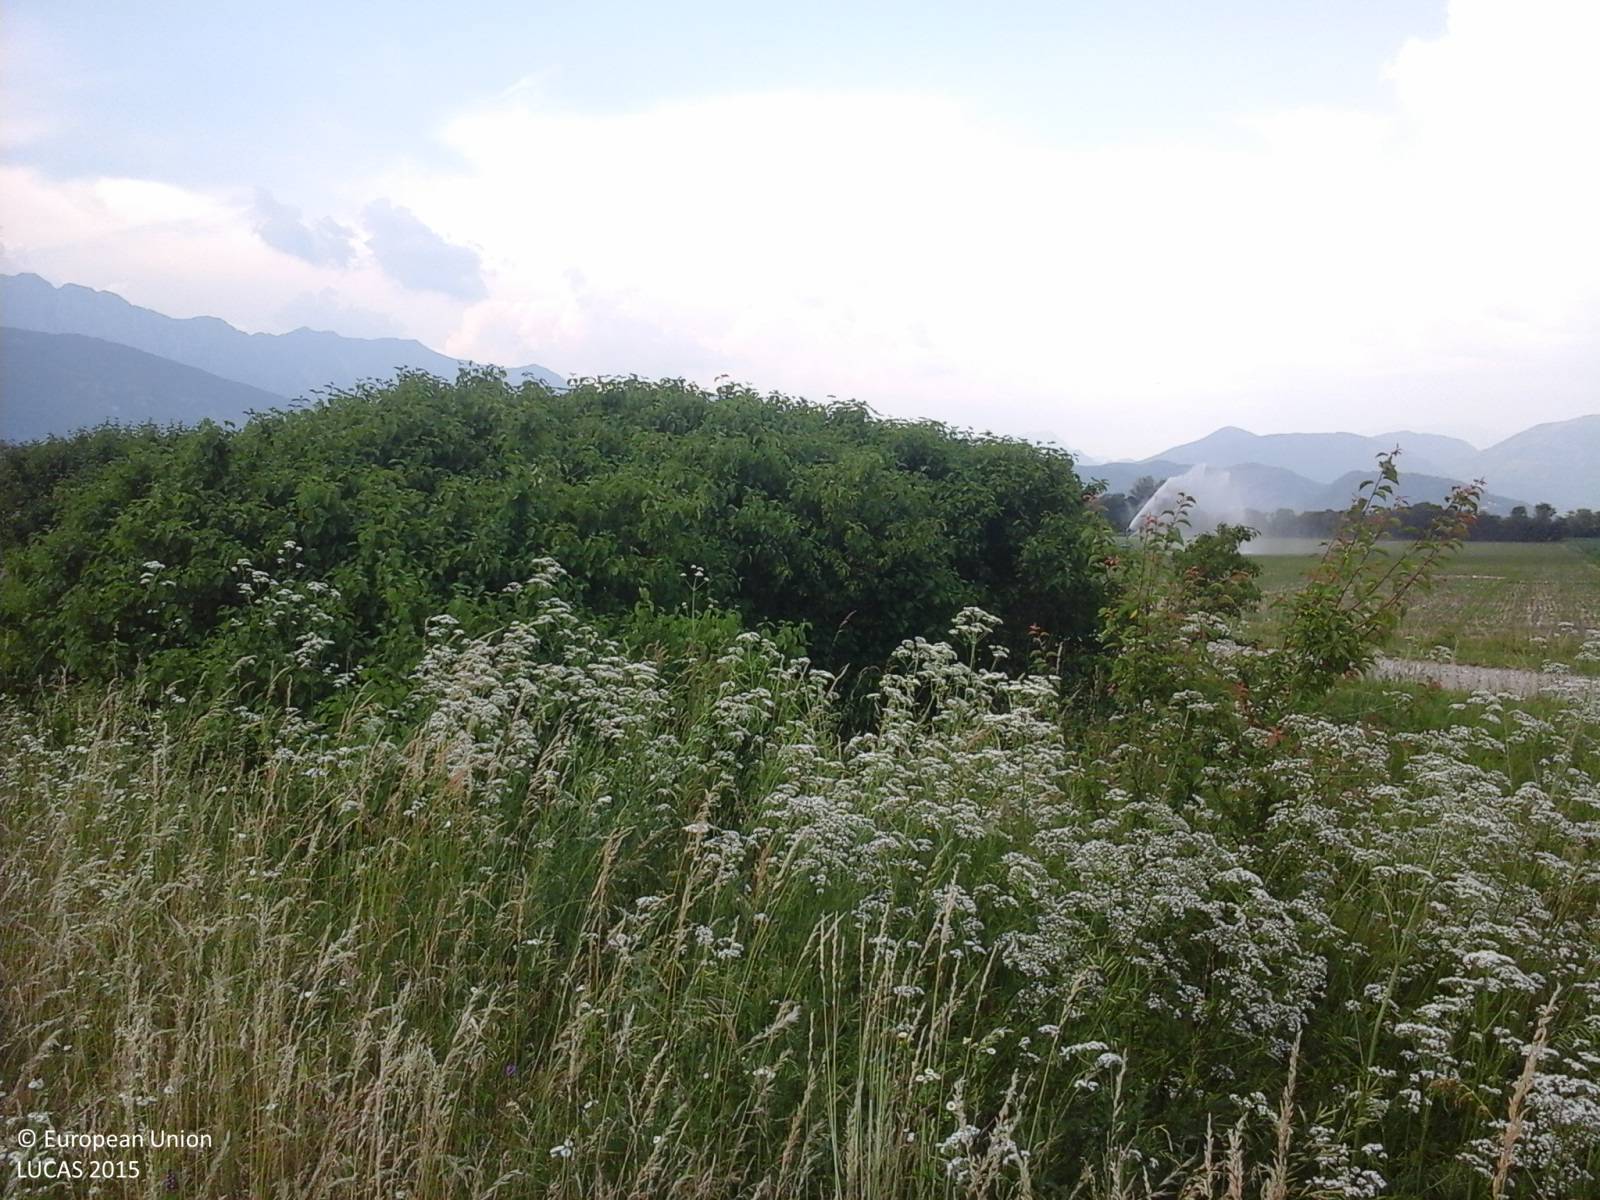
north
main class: Grassland
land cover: Grassland without tree/shrub cover
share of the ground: > 75 %
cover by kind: herbaceous plants 100 %
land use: Agriculture (excluding fallow land and kitchen gardens)
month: June
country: IT
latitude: 46.1362
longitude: 12.7280
